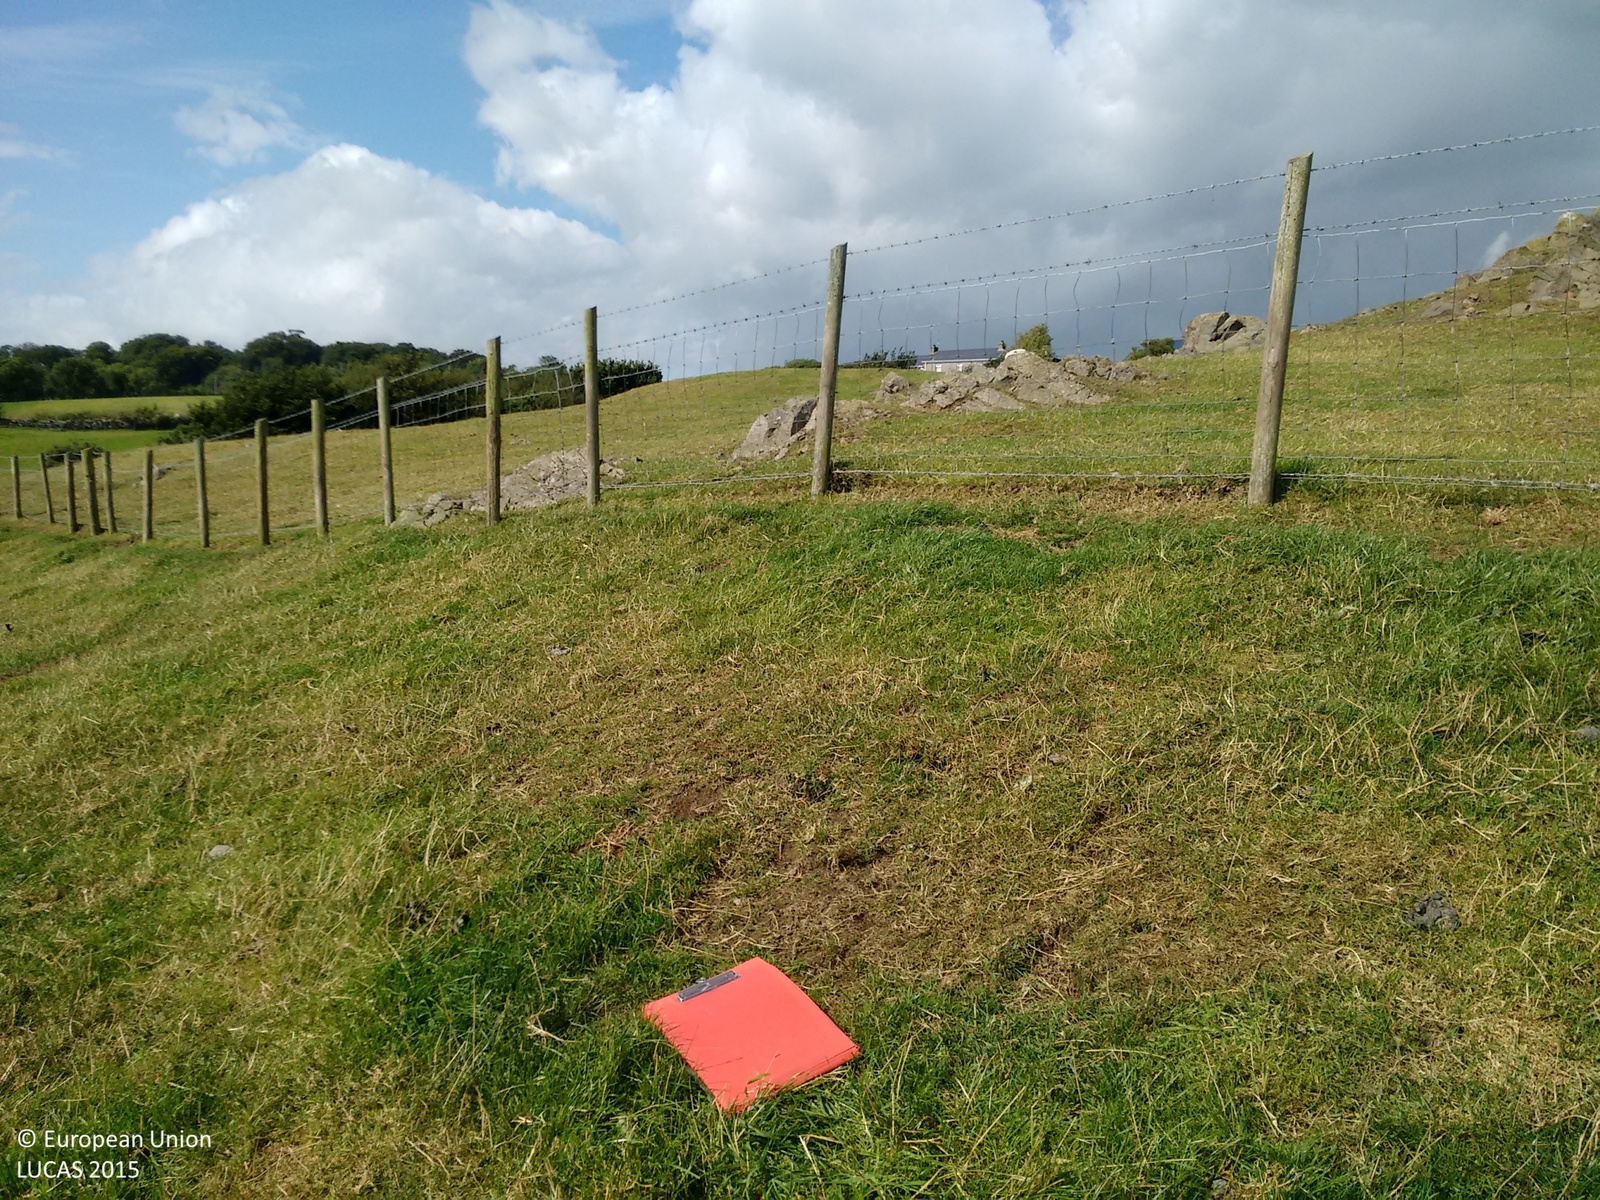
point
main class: Grassland
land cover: Grassland without tree/shrub cover
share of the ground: > 75 %
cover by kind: herbaceous plants 100 %
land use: Agriculture (excluding fallow land and kitchen gardens)
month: August
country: GB
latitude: 54.4639
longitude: -5.6677
